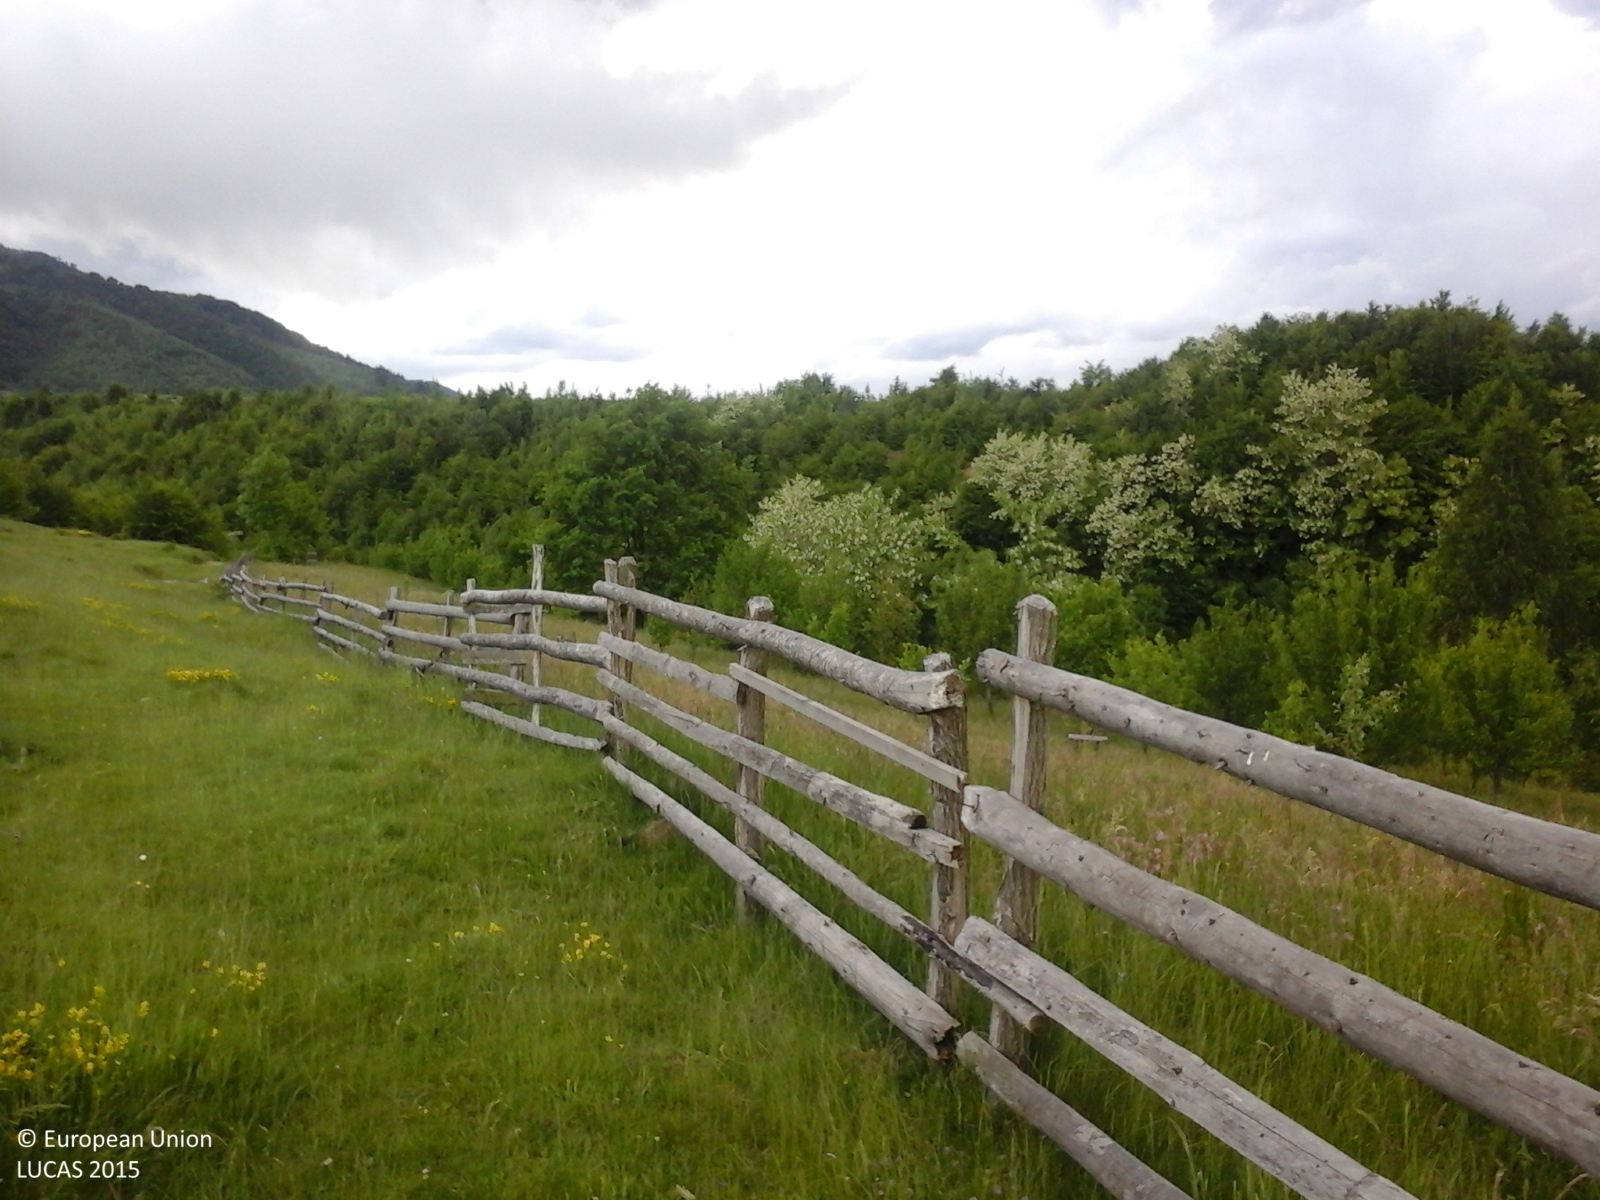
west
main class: Grassland
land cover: Grassland without tree/shrub cover
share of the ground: > 75 %
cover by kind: herbaceous plants 100 %
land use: Agriculture (excluding fallow land and kitchen gardens)
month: May
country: RO
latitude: 45.6913
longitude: 25.2363
